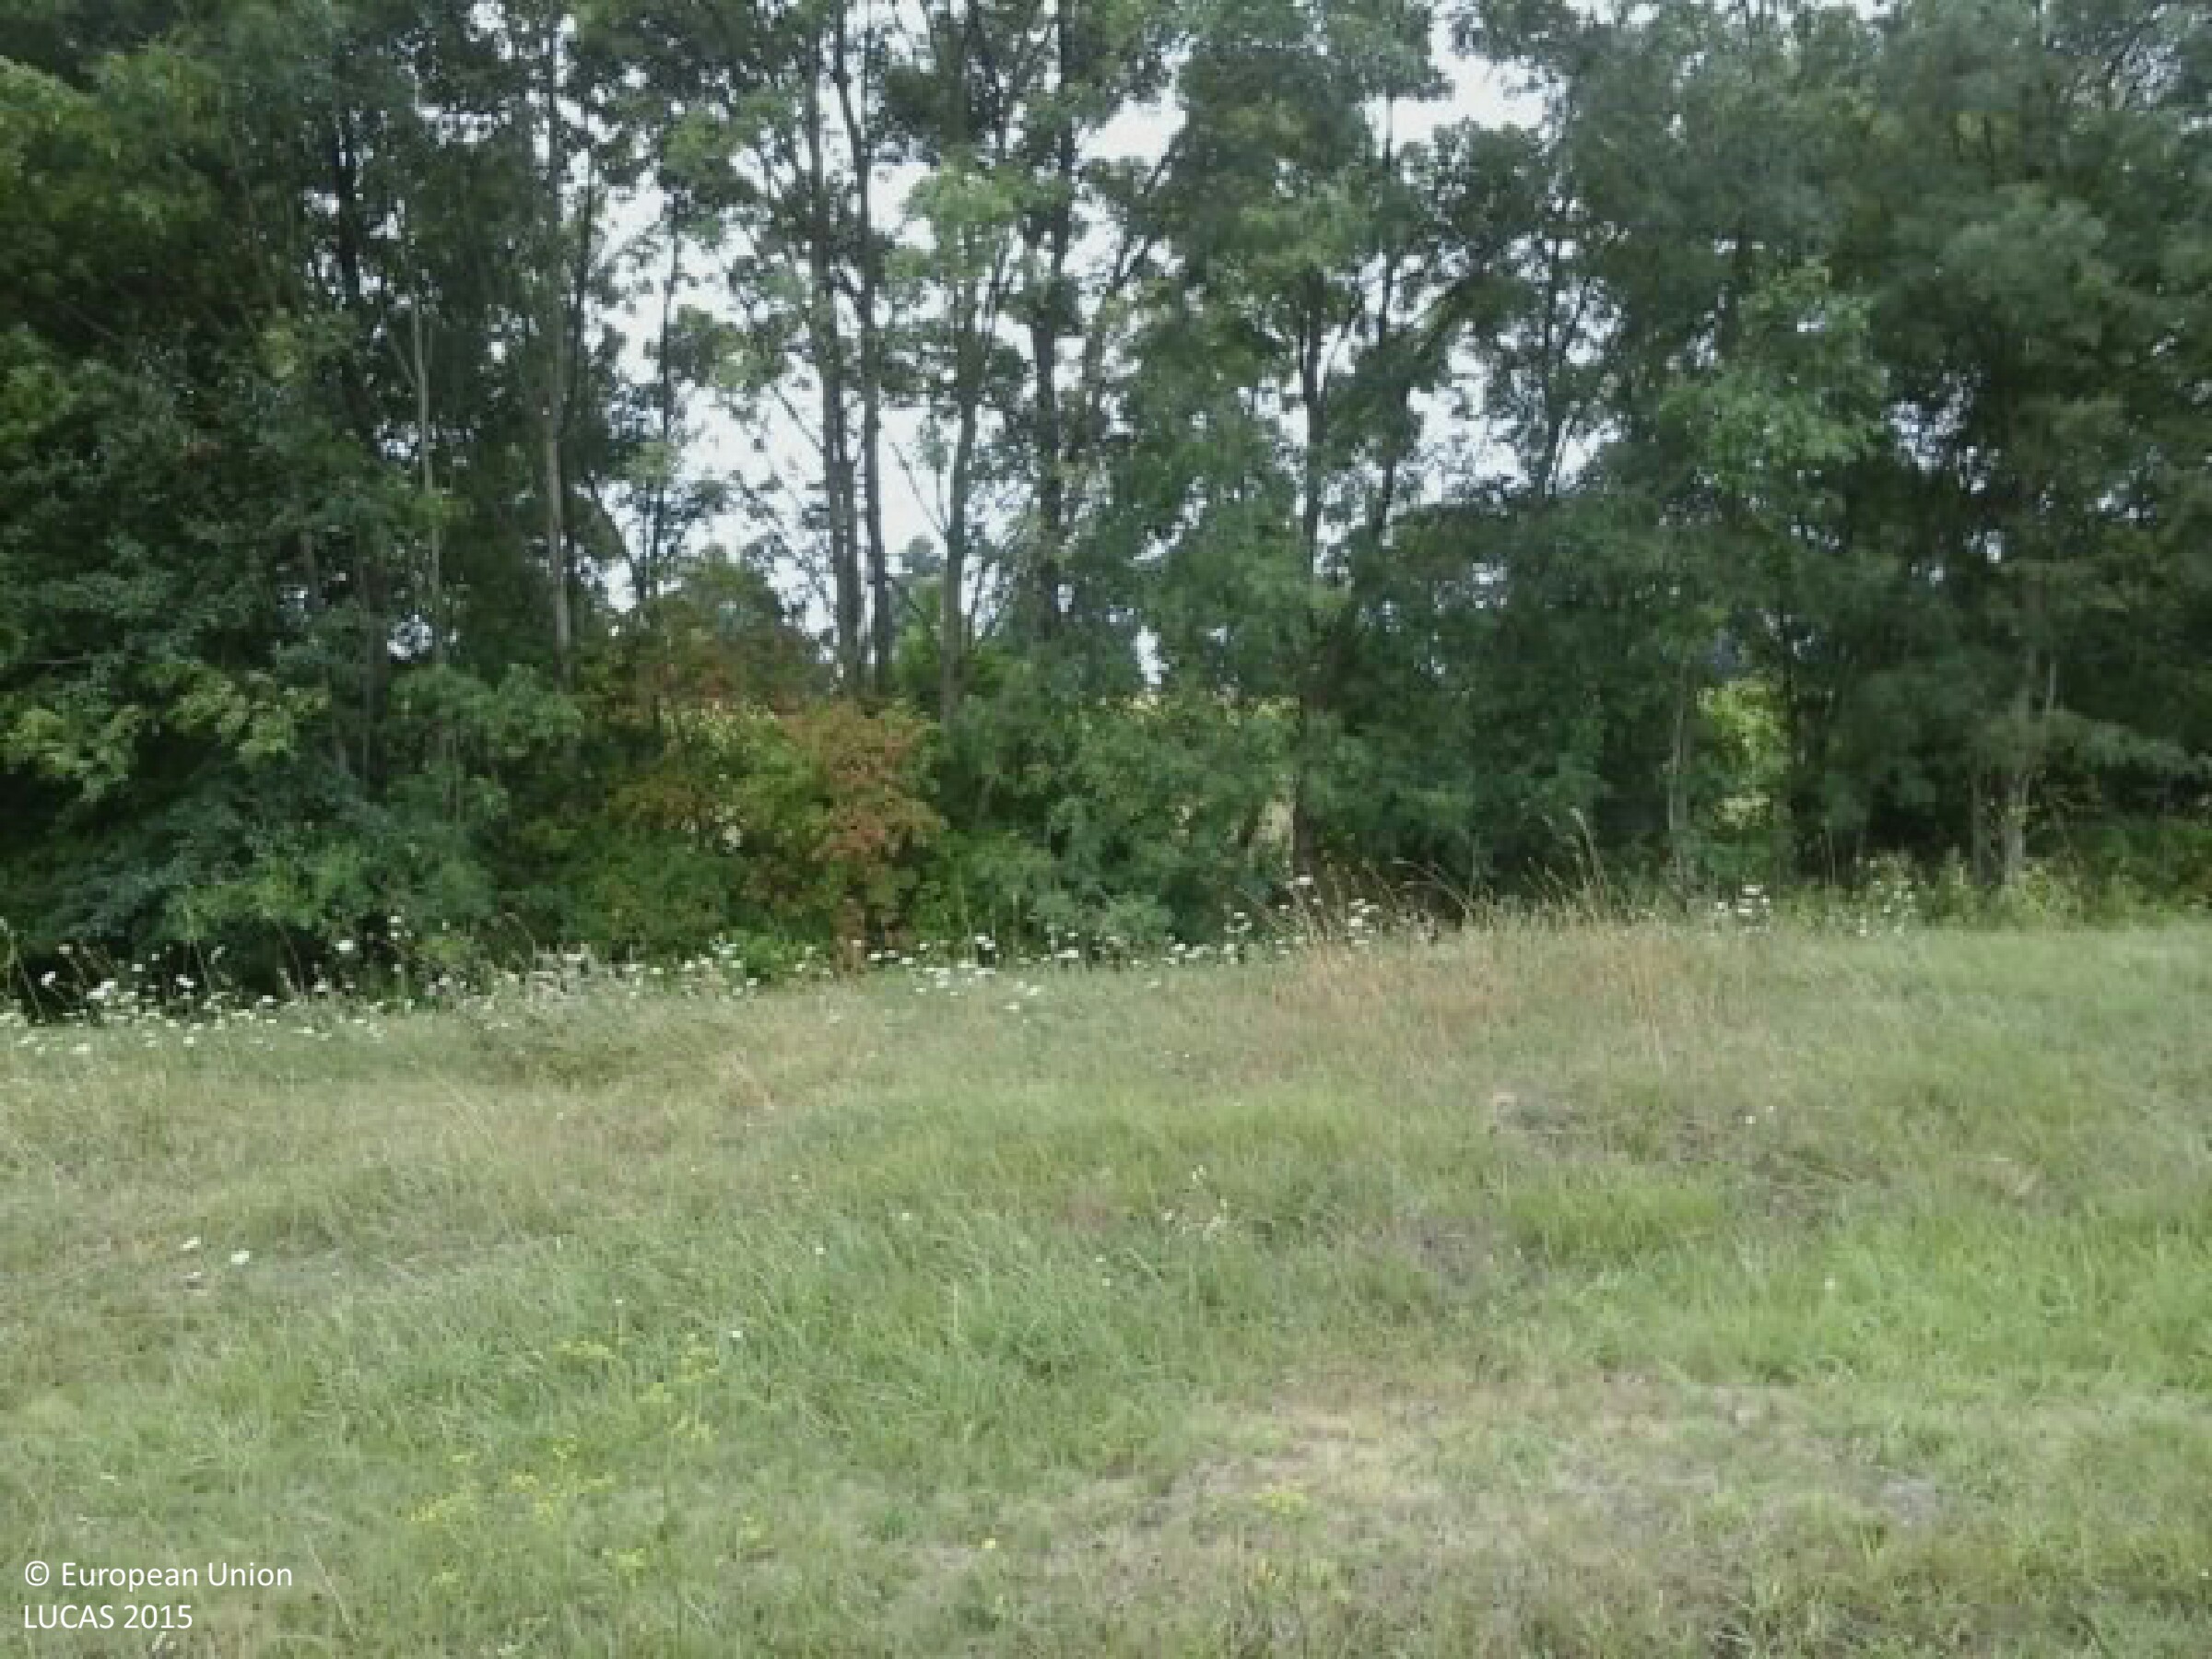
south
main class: Grassland
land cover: Grassland without tree/shrub cover
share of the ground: > 75 %
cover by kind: herbaceous plants 100 %
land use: Agriculture (excluding fallow land and kitchen gardens)
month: July
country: HU
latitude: 47.0473
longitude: 19.7491
